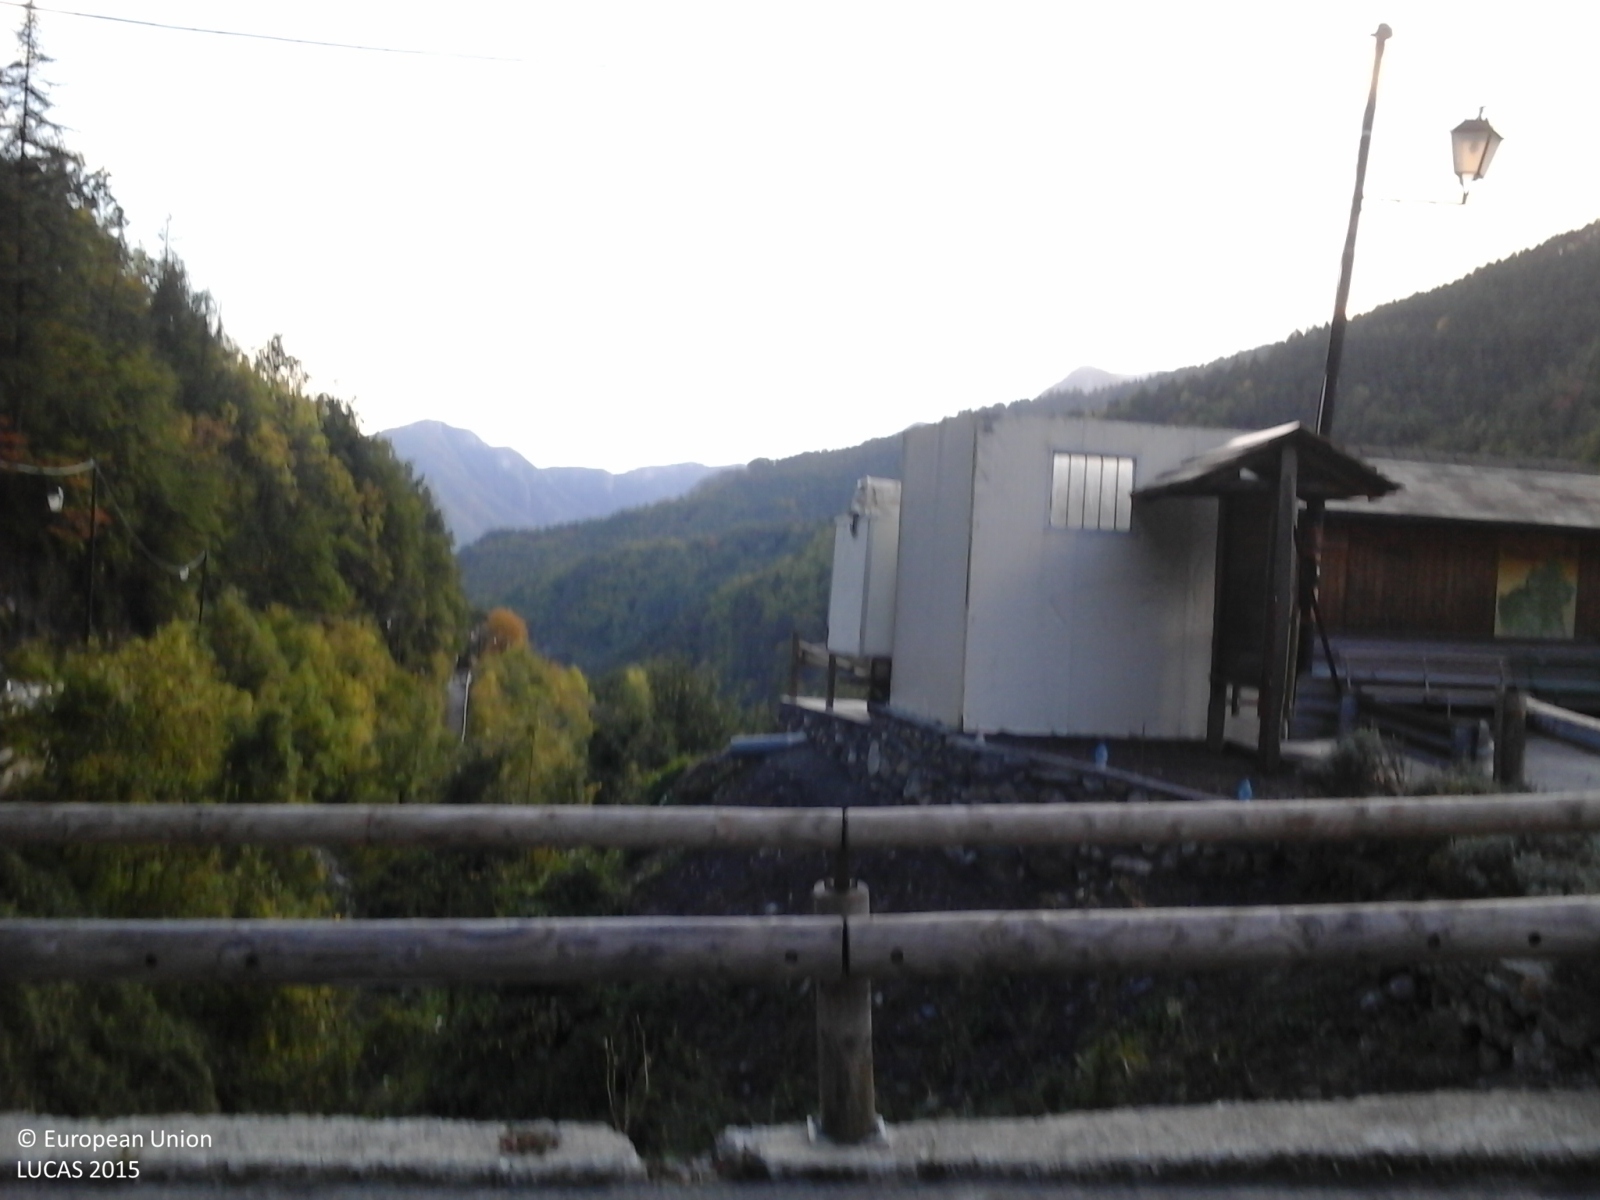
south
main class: Woodland
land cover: Other coniferous woodland
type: alpine coniferous forest
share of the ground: > 75 %
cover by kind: coniferous forest trees 70 %, herbaceous plants 30 %
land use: Semi-natural and natural areas not in use
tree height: > 5 m
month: October
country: IT
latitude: 44.0549
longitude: 7.7210
